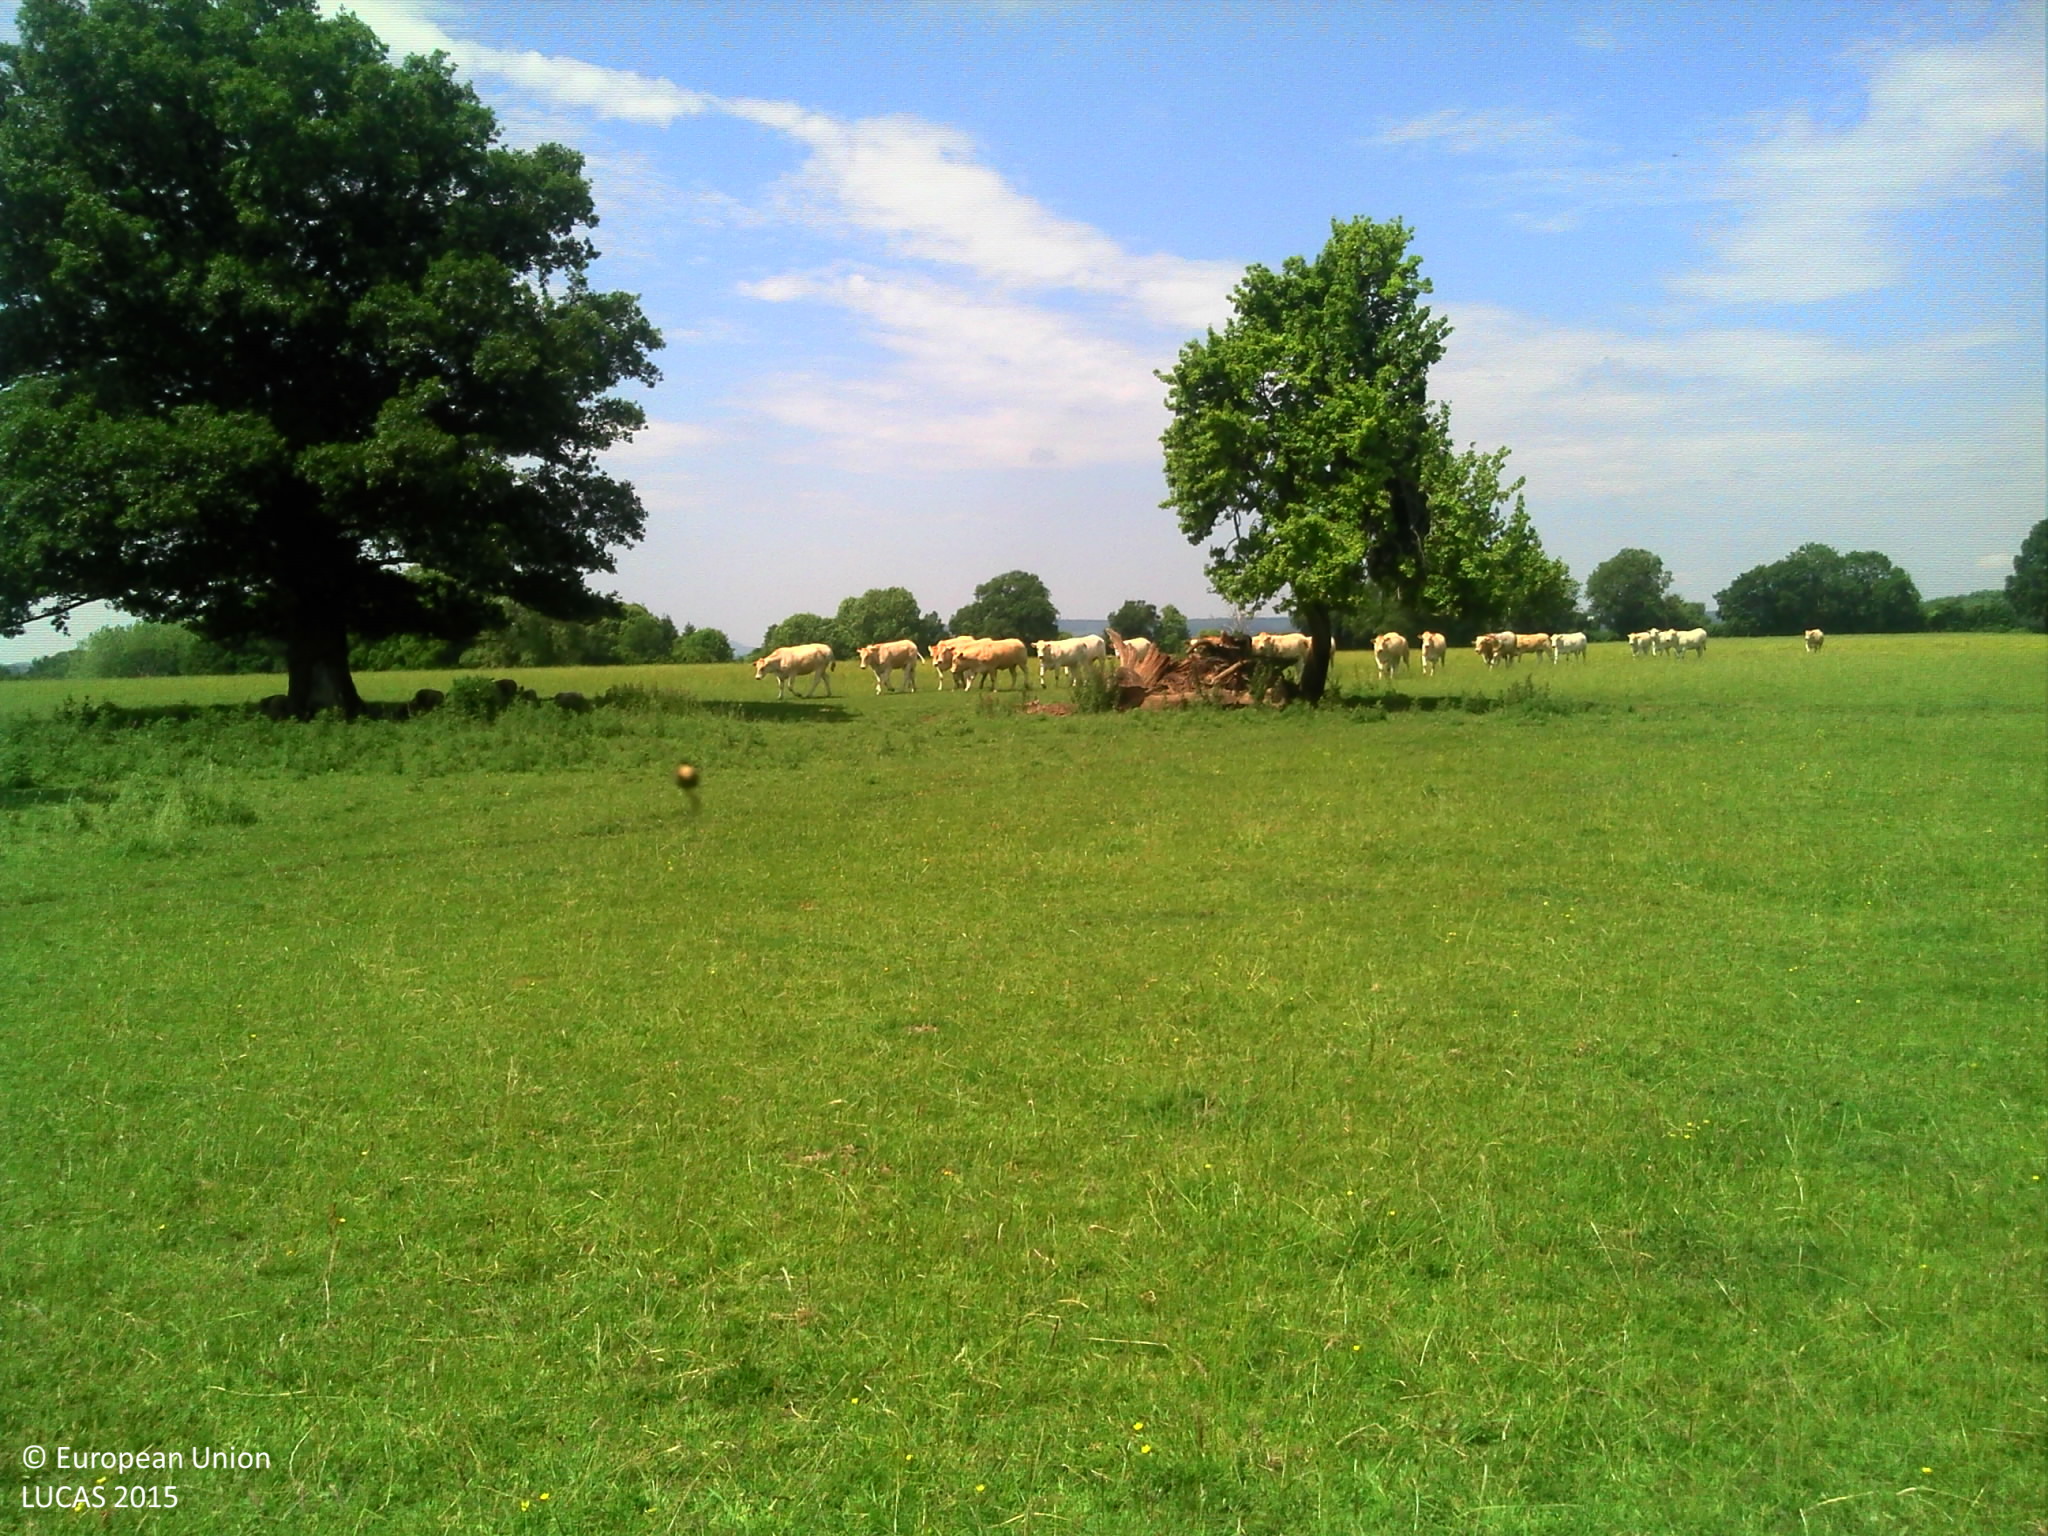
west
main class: Grassland
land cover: Grassland without tree/shrub cover
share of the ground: > 75 %
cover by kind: herbaceous plants 95 %
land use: Agriculture (excluding fallow land and kitchen gardens)
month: June
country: FR
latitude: 48.5096
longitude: 0.1855
